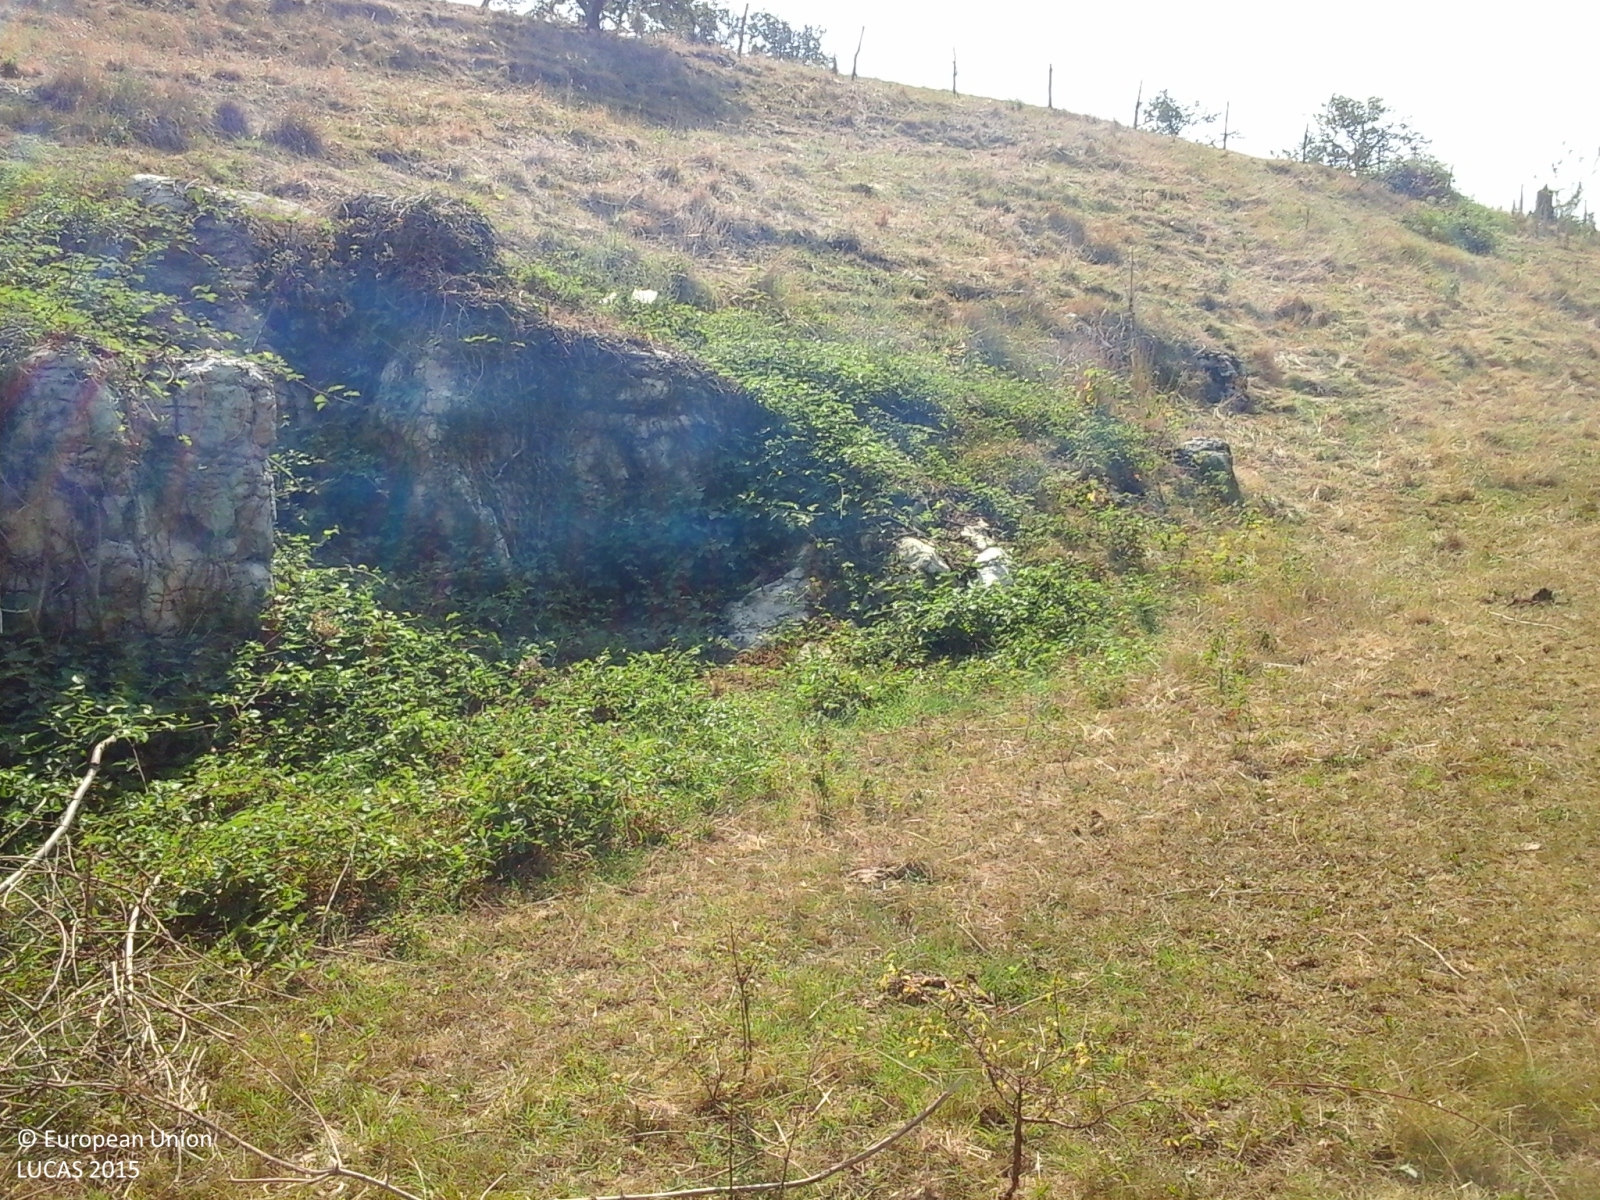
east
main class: Grassland
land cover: Grassland without tree/shrub cover
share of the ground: > 75 %
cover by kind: herbaceous plants 100 %
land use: Agriculture (excluding fallow land and kitchen gardens)
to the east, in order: Grassland without tree/shrub cover; Fences; Grassland with sparse tree/shrub cover; Grassland without tree/shrub cover; Fences; Lucerne; Electric lines; Lucerne; Cherry fruit
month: July
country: IT
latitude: 45.5346
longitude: 11.1122
